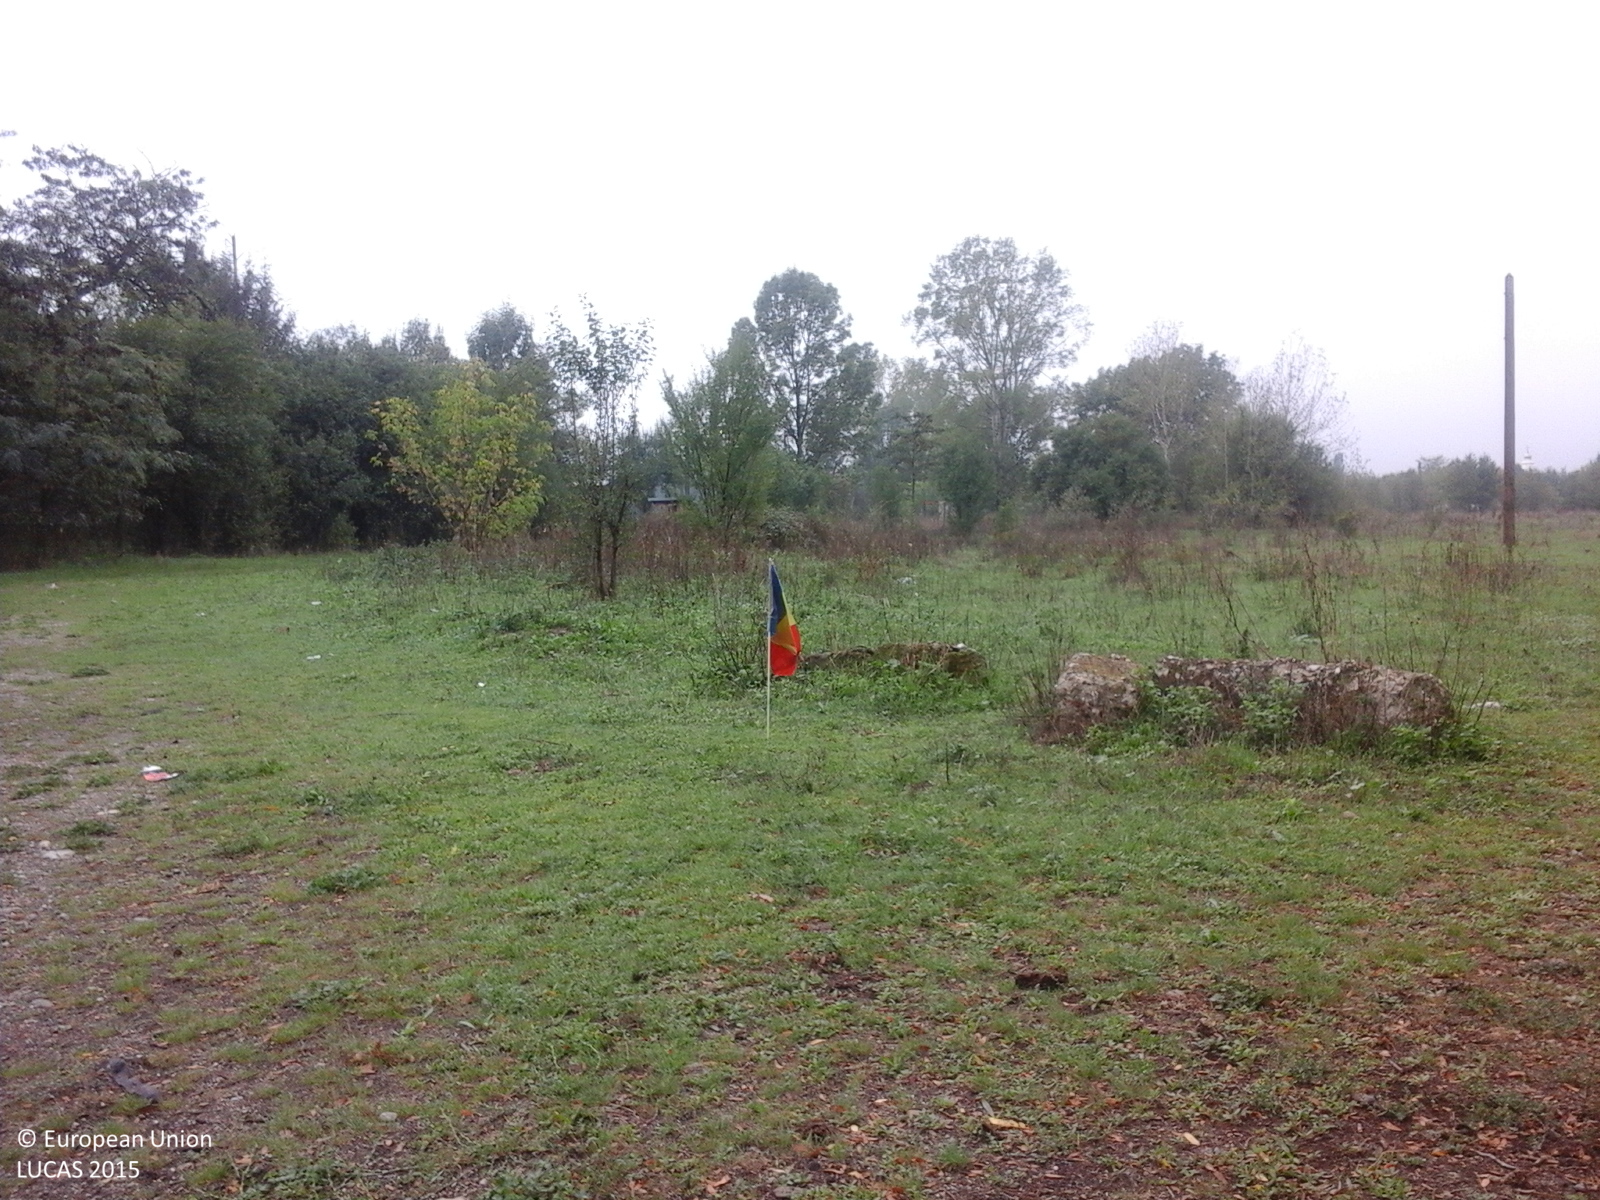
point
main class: Grassland
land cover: Grassland without tree/shrub cover
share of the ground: > 75 %
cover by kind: herbaceous plants 100 %
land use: Agriculture (excluding fallow land and kitchen gardens)
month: September
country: RO
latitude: 45.0424
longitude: 23.2954
